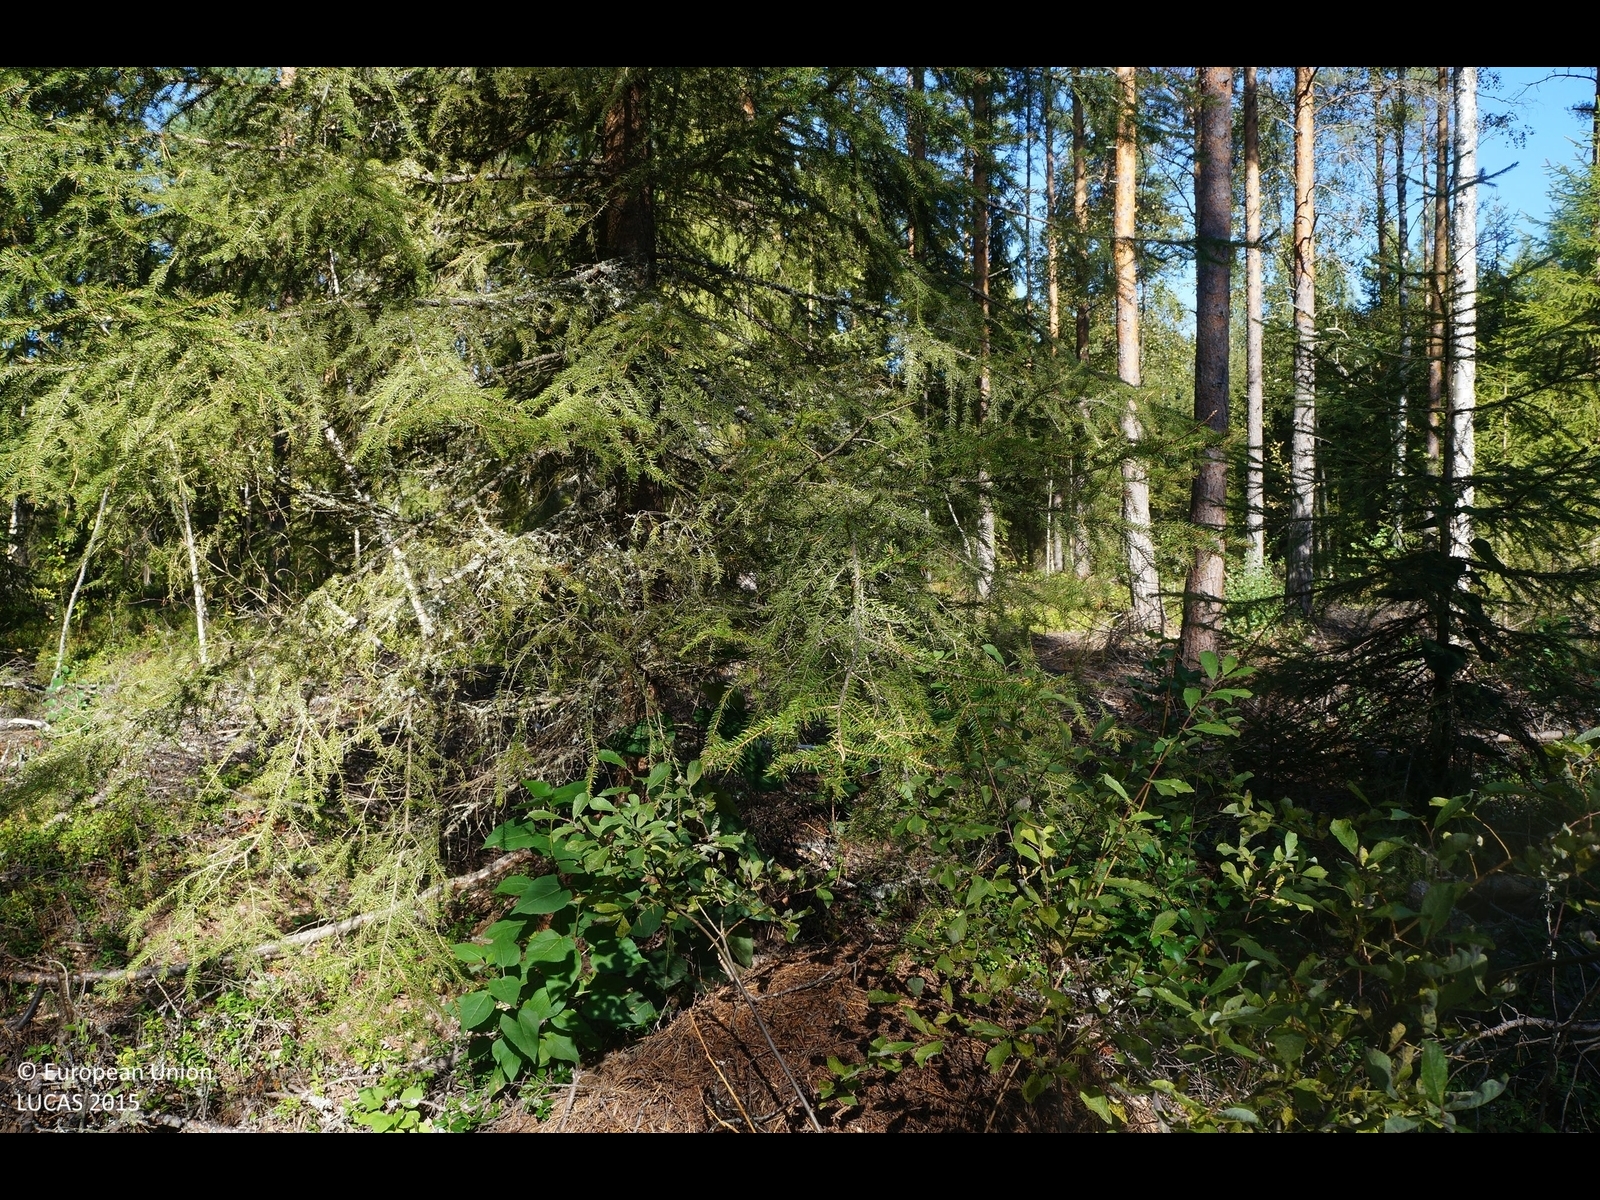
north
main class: Woodland
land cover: Other mixed woodland
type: boreal forest
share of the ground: 50 - 75 %
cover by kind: coniferous forest trees 40 %, shrubs 30 %, broadleaved forest trees 20 %, lichens and mosses 10 %
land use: Forestry
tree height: > 5 m
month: September
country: FI
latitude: 63.8615
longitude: 24.0448
